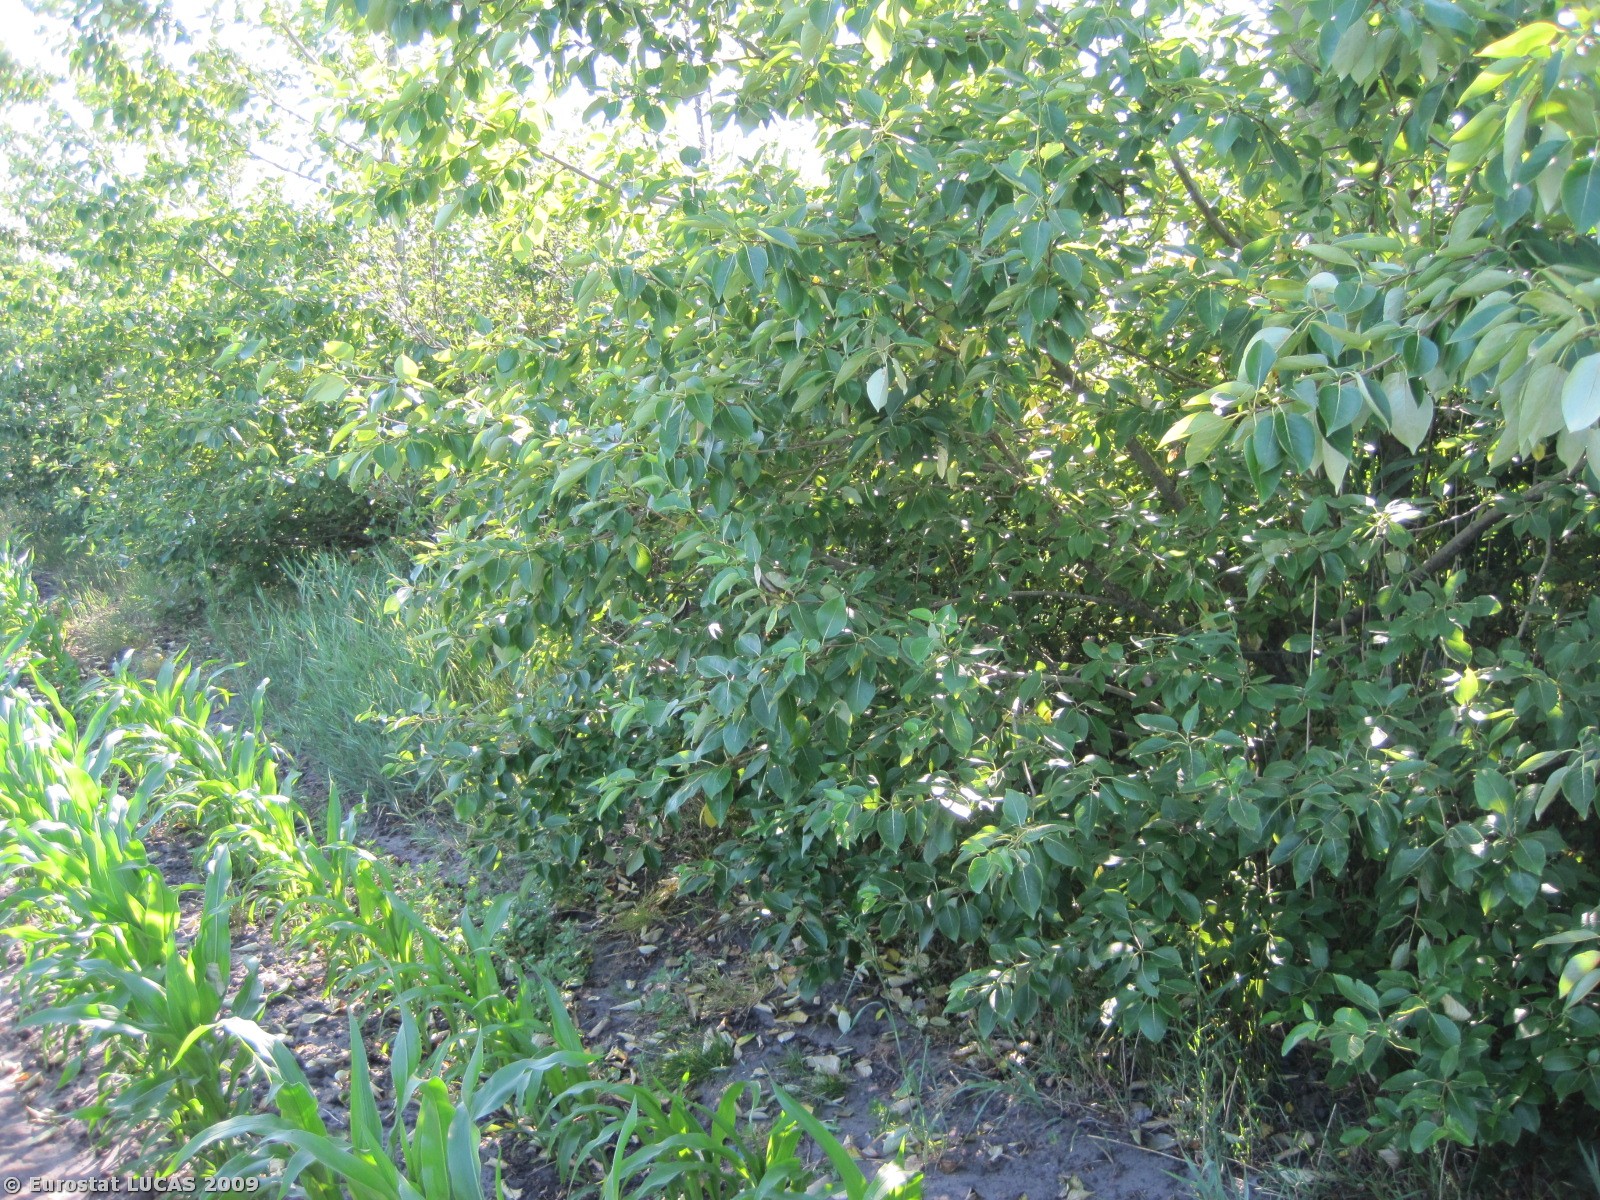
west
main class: Woodland
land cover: Broadleaved woodland
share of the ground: 25 - 50 %
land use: Forestry
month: July
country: DK
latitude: 56.3767
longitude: 8.4959
